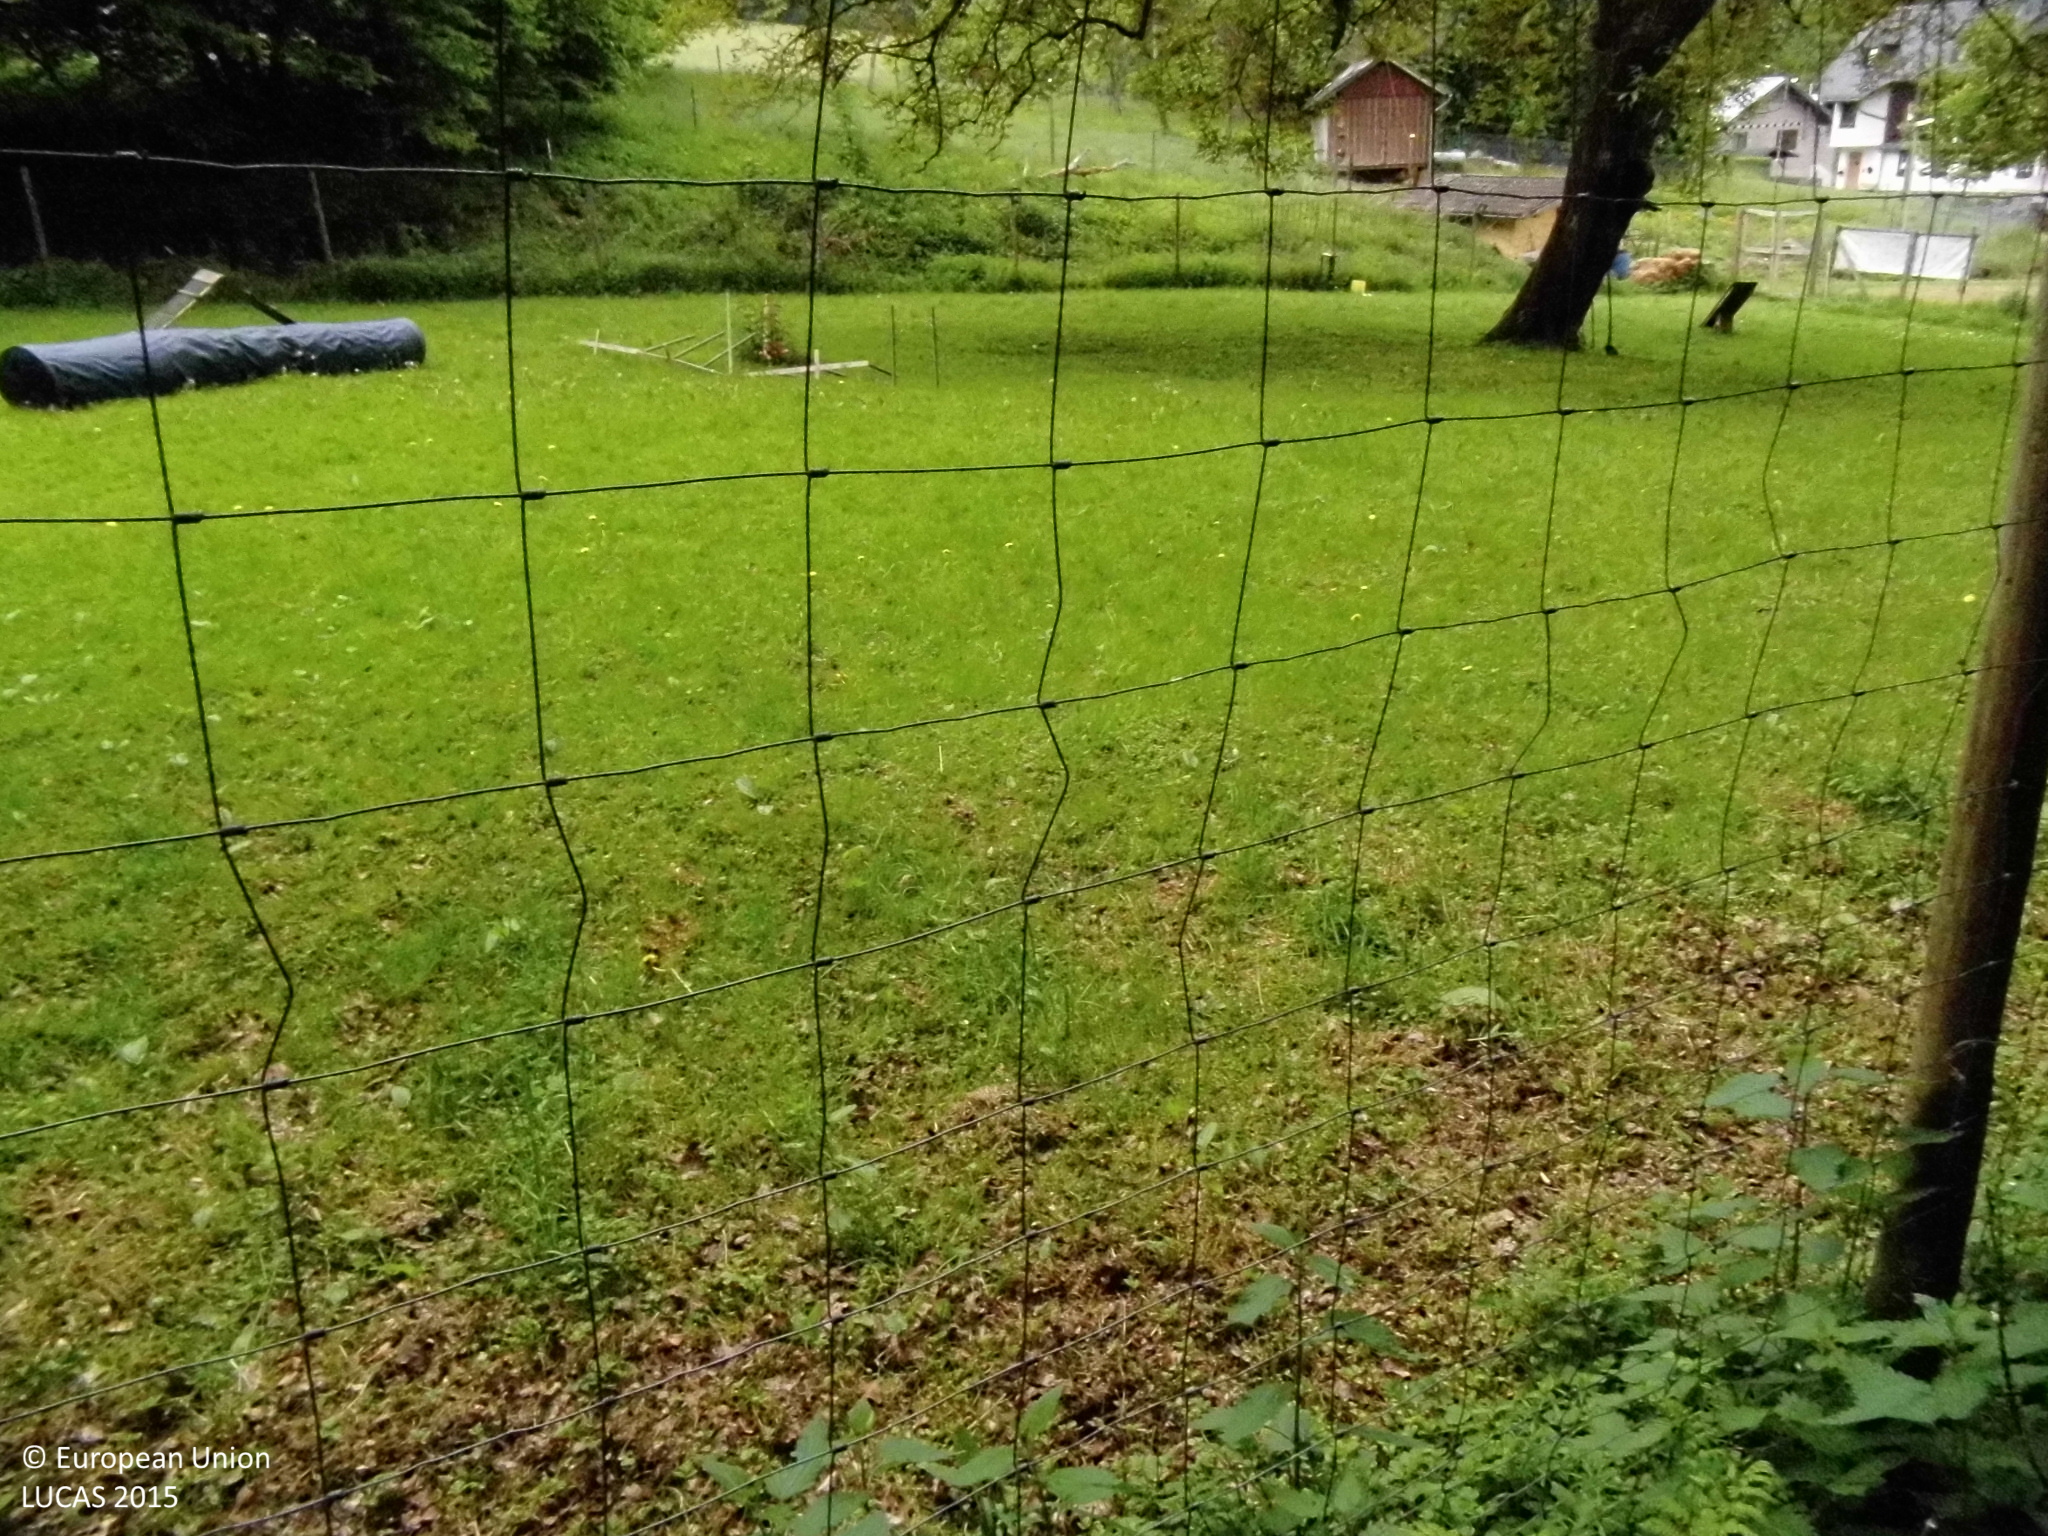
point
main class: Grassland
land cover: Grassland with sparse tree/shrub cover
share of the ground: > 75 %
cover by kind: herbaceous plants 95 %, broadleaved forest trees 5 %
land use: Amenities, museums, leisure
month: May
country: DE
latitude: 50.5712
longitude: 7.5293
